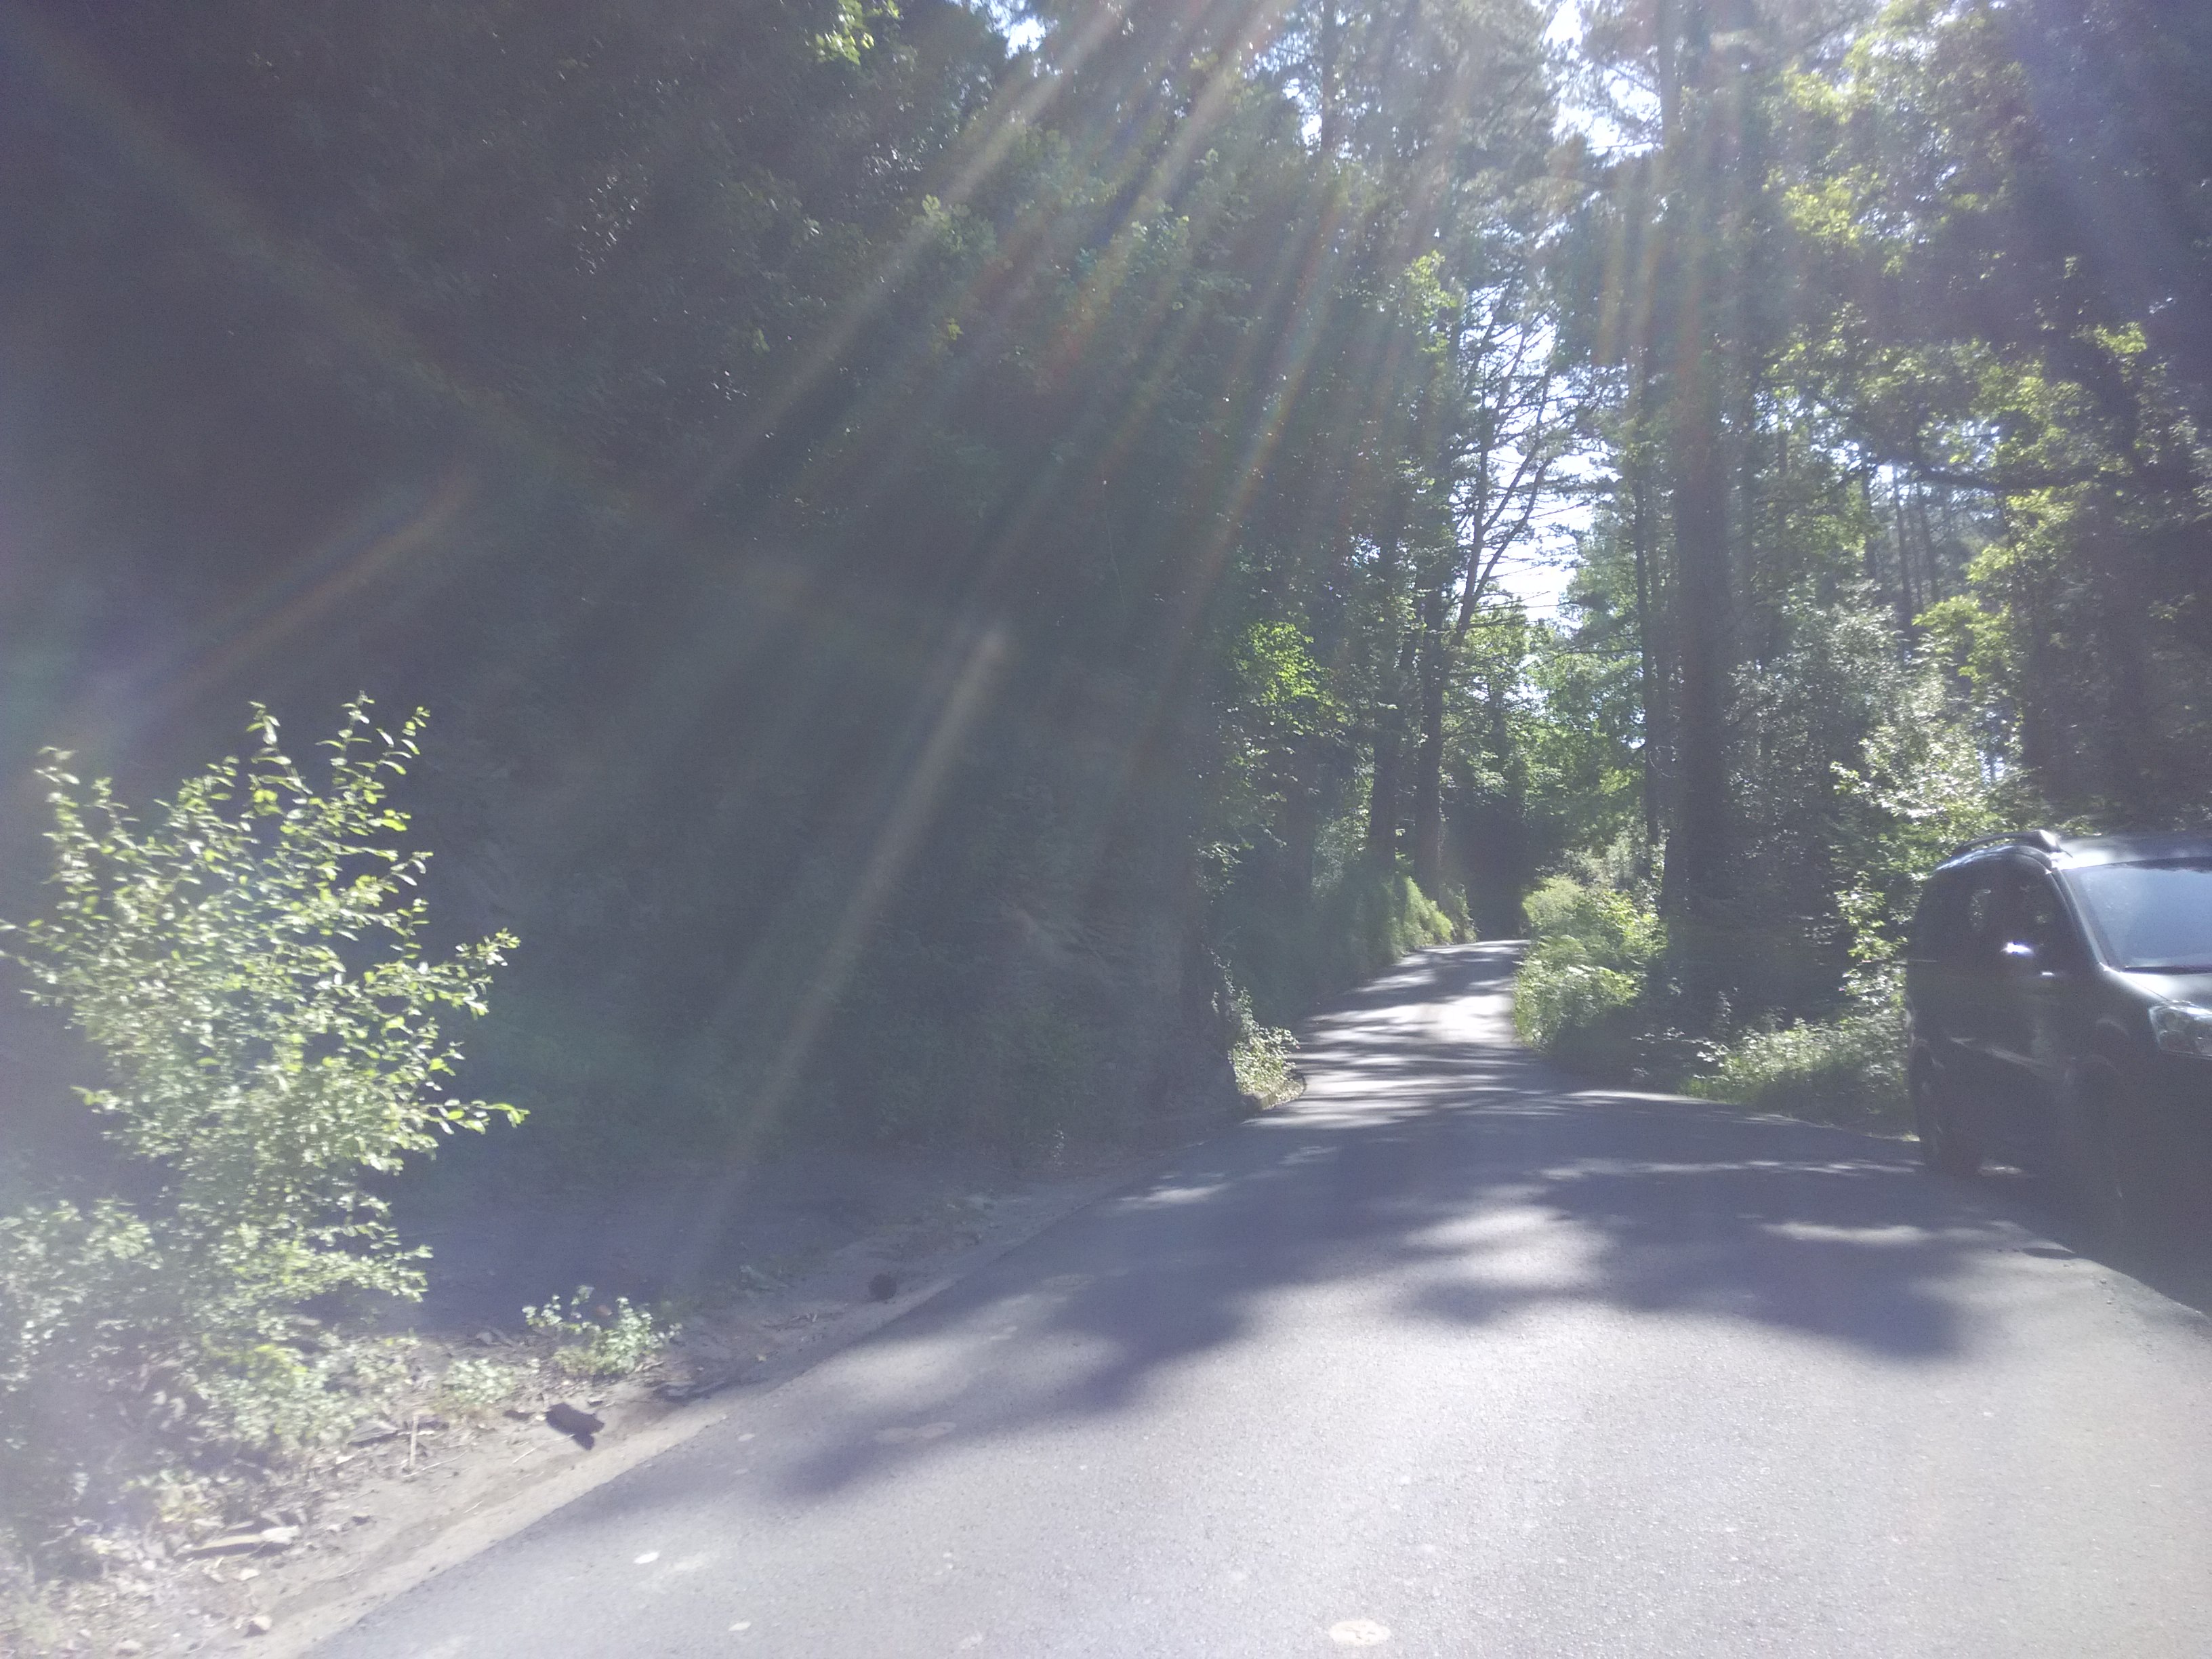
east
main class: Woodland
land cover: Pine dominated coniferous woodland
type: exotic forest
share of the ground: > 75 %
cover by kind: coniferous forest trees 75 %, broadleaved forest trees 15 %, unconsolidated bare surface 10 %
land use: Forestry
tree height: > 5 m
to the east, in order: Pine dominated coniferous woodland; Paved roads, cycling and walking lanes; Fences; Grassland without tree/shrub cover; Fences; Grassland without tree/shrub cover; Artificial constructions in urban areas
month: June
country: ES
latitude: 43.2562
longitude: -2.5564
